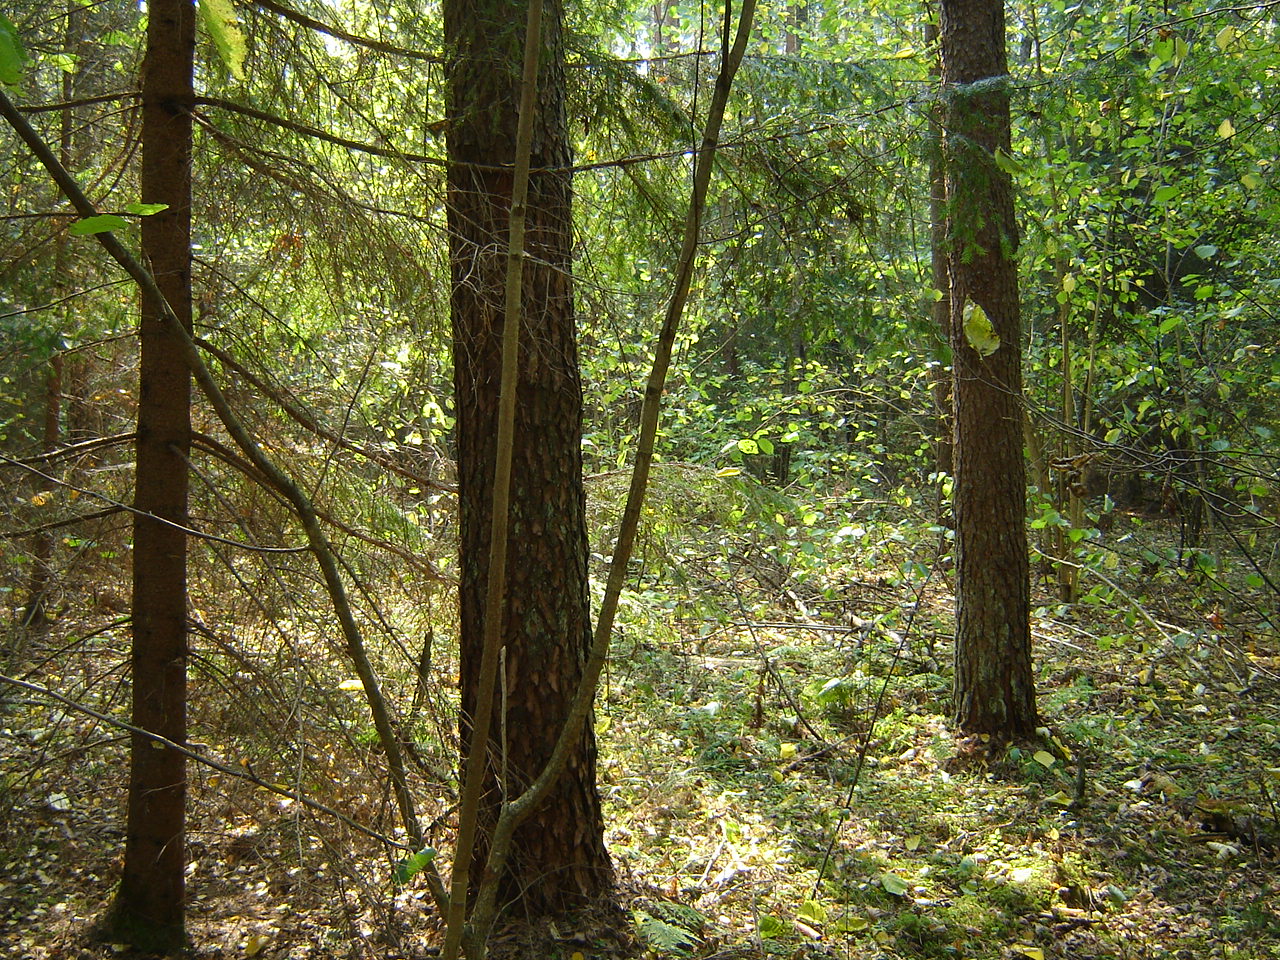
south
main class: Woodland
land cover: Pine dominated mixed woodland
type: hemiboreal forest and nemoral coniferous forest and mixed broadleaved-coniferous forest
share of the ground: > 75 %
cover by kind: coniferous forest trees 60 %, broadleaved forest trees 30 %, unconsolidated bare surface 10 %
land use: Forestry
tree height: > 5 m
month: September
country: LT
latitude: 54.5537
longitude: 25.0995
